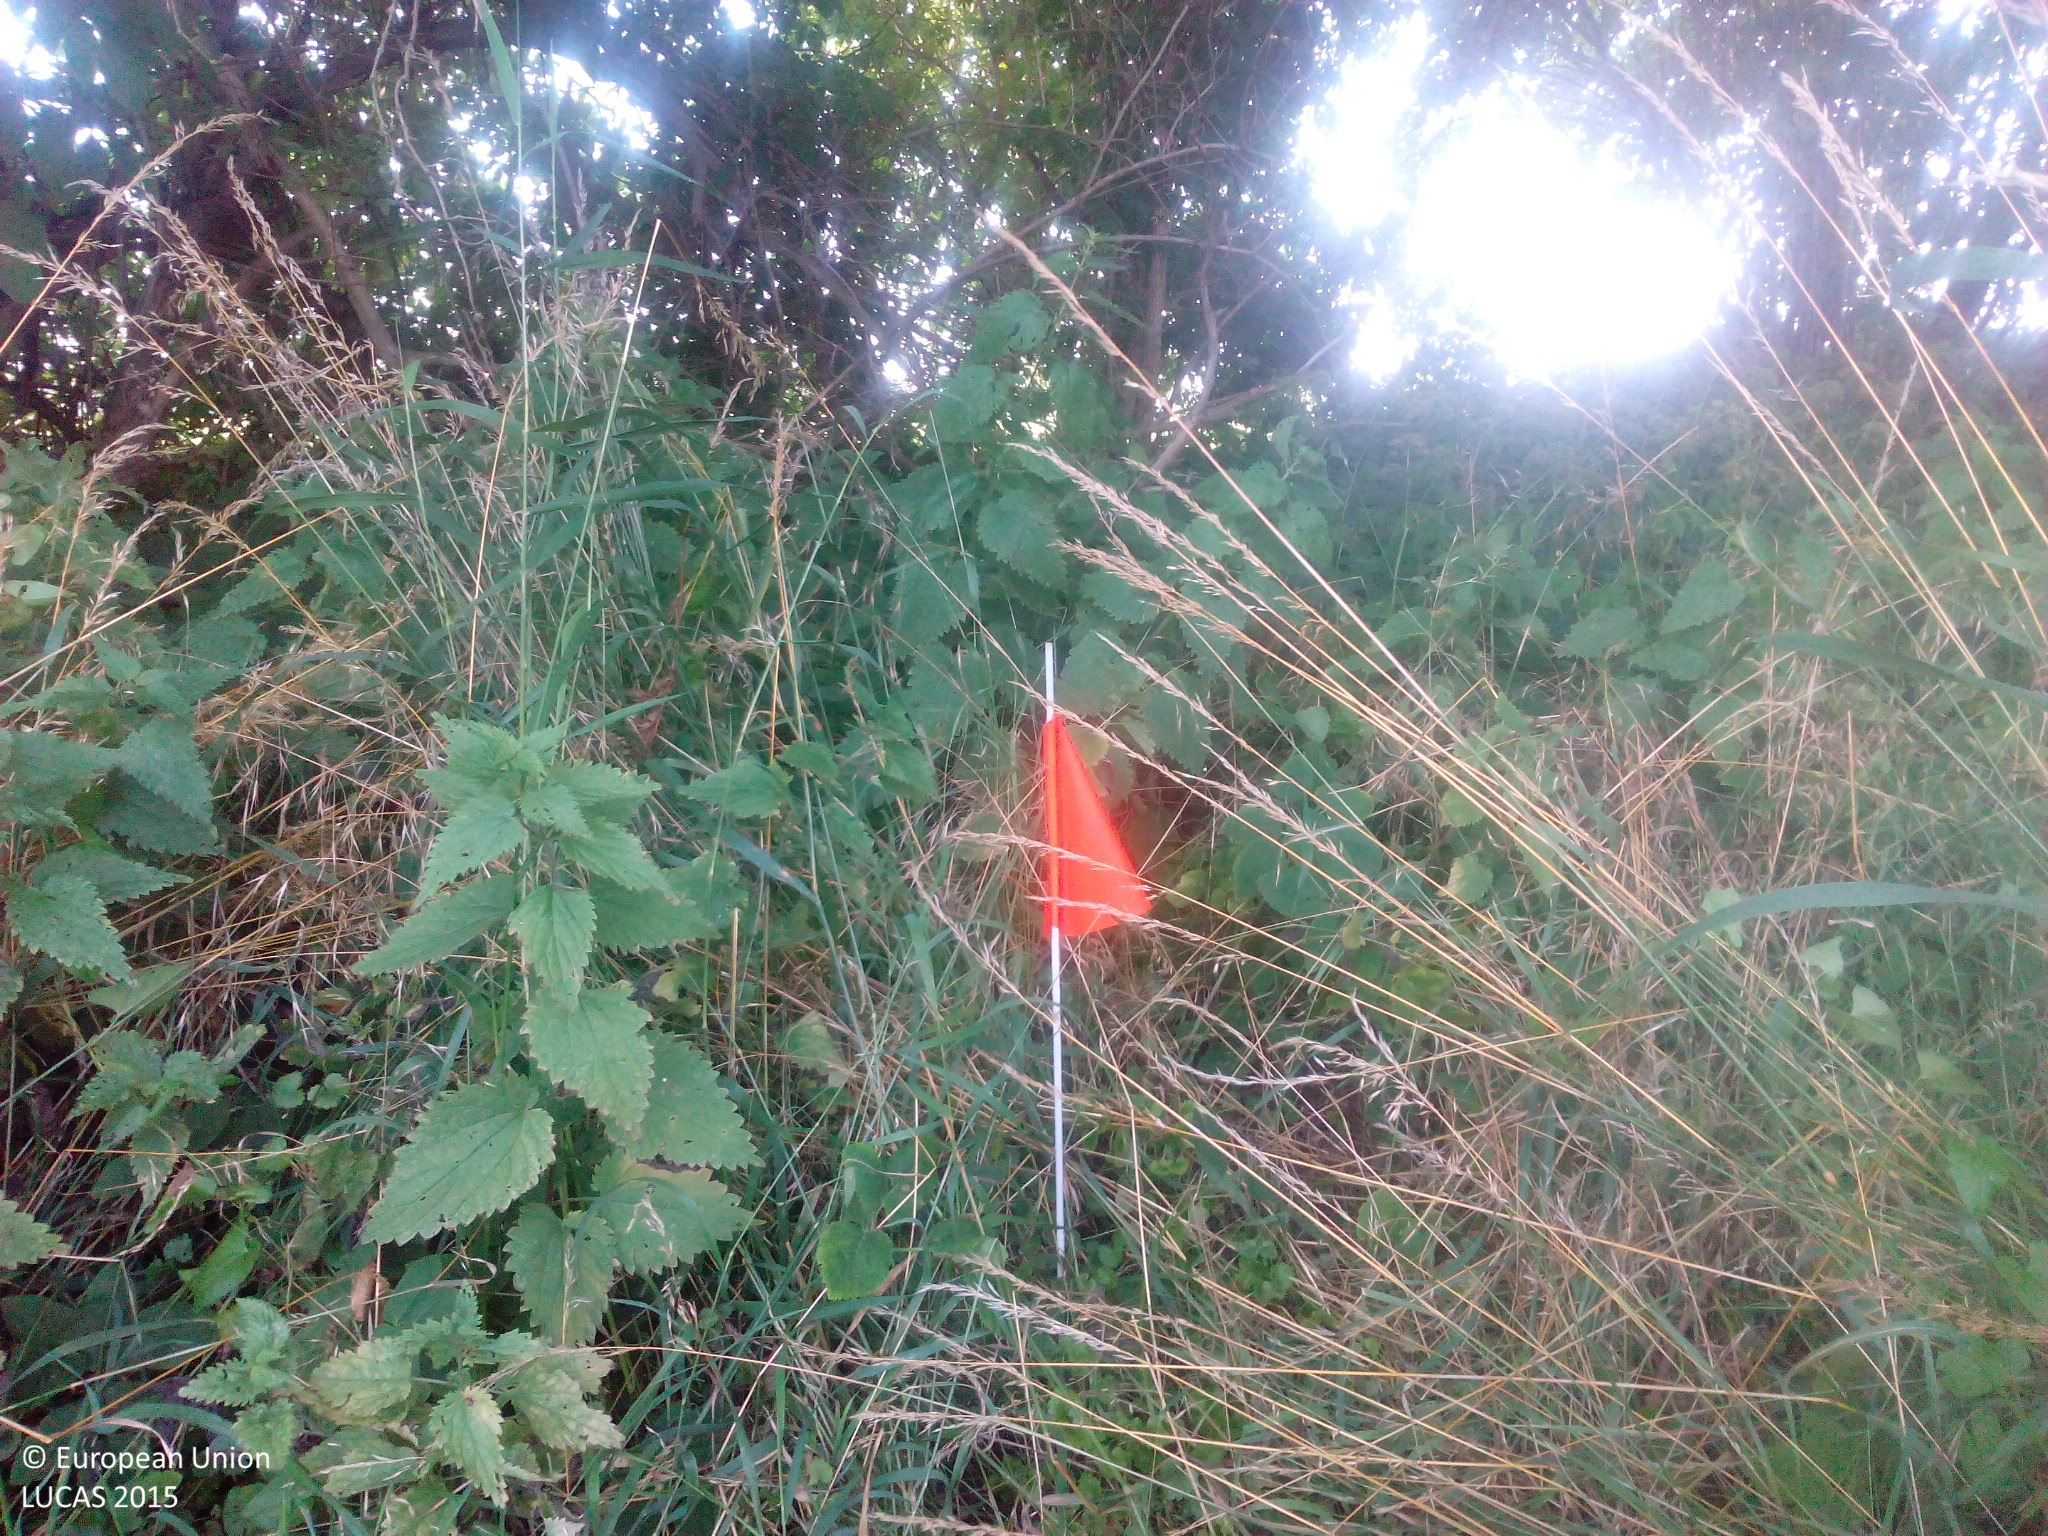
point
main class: Woodland
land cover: Broadleaved woodland
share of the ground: > 75 %
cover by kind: broadleaved forest trees 95 %, shrubs 5 %
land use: Forestry
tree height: > 5 m
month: July
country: DE
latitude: 51.9827
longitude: 12.0235
